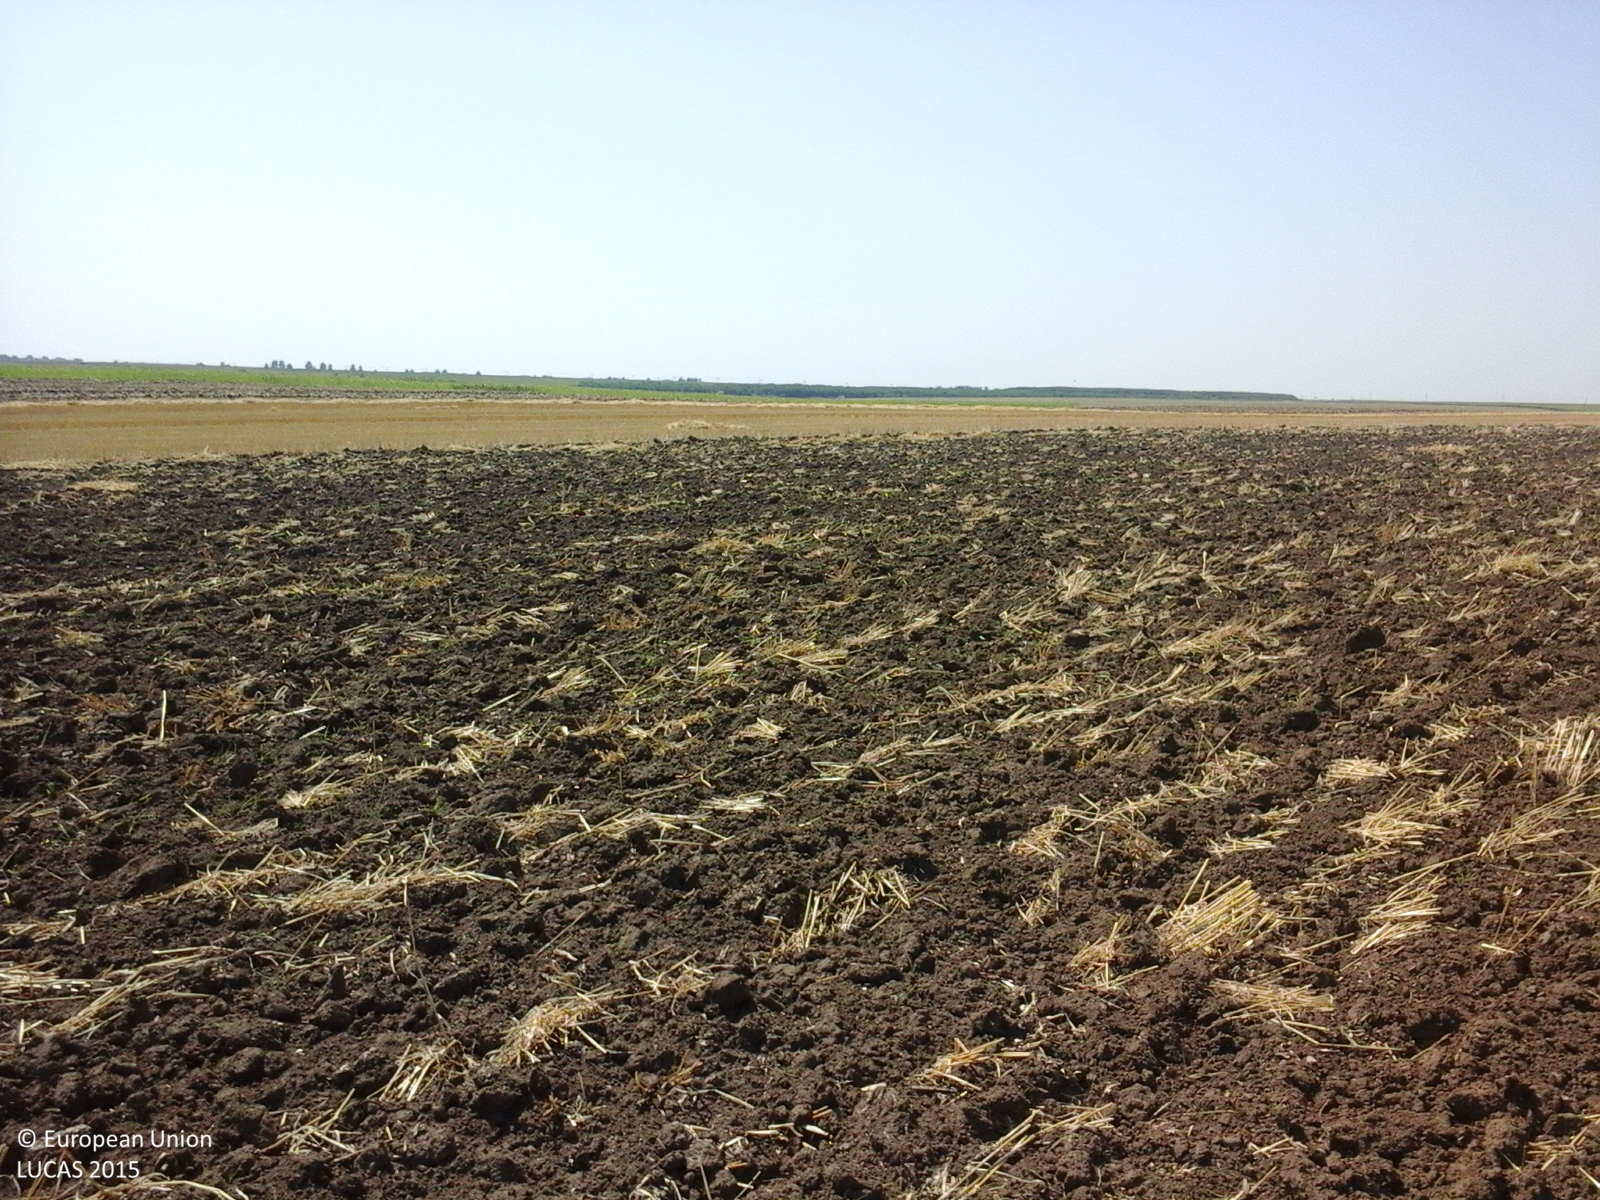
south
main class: Cropland
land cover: Barley
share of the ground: < 10 %
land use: Agriculture (excluding fallow land and kitchen gardens)
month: July
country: RO
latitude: 44.4585
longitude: 26.8009
